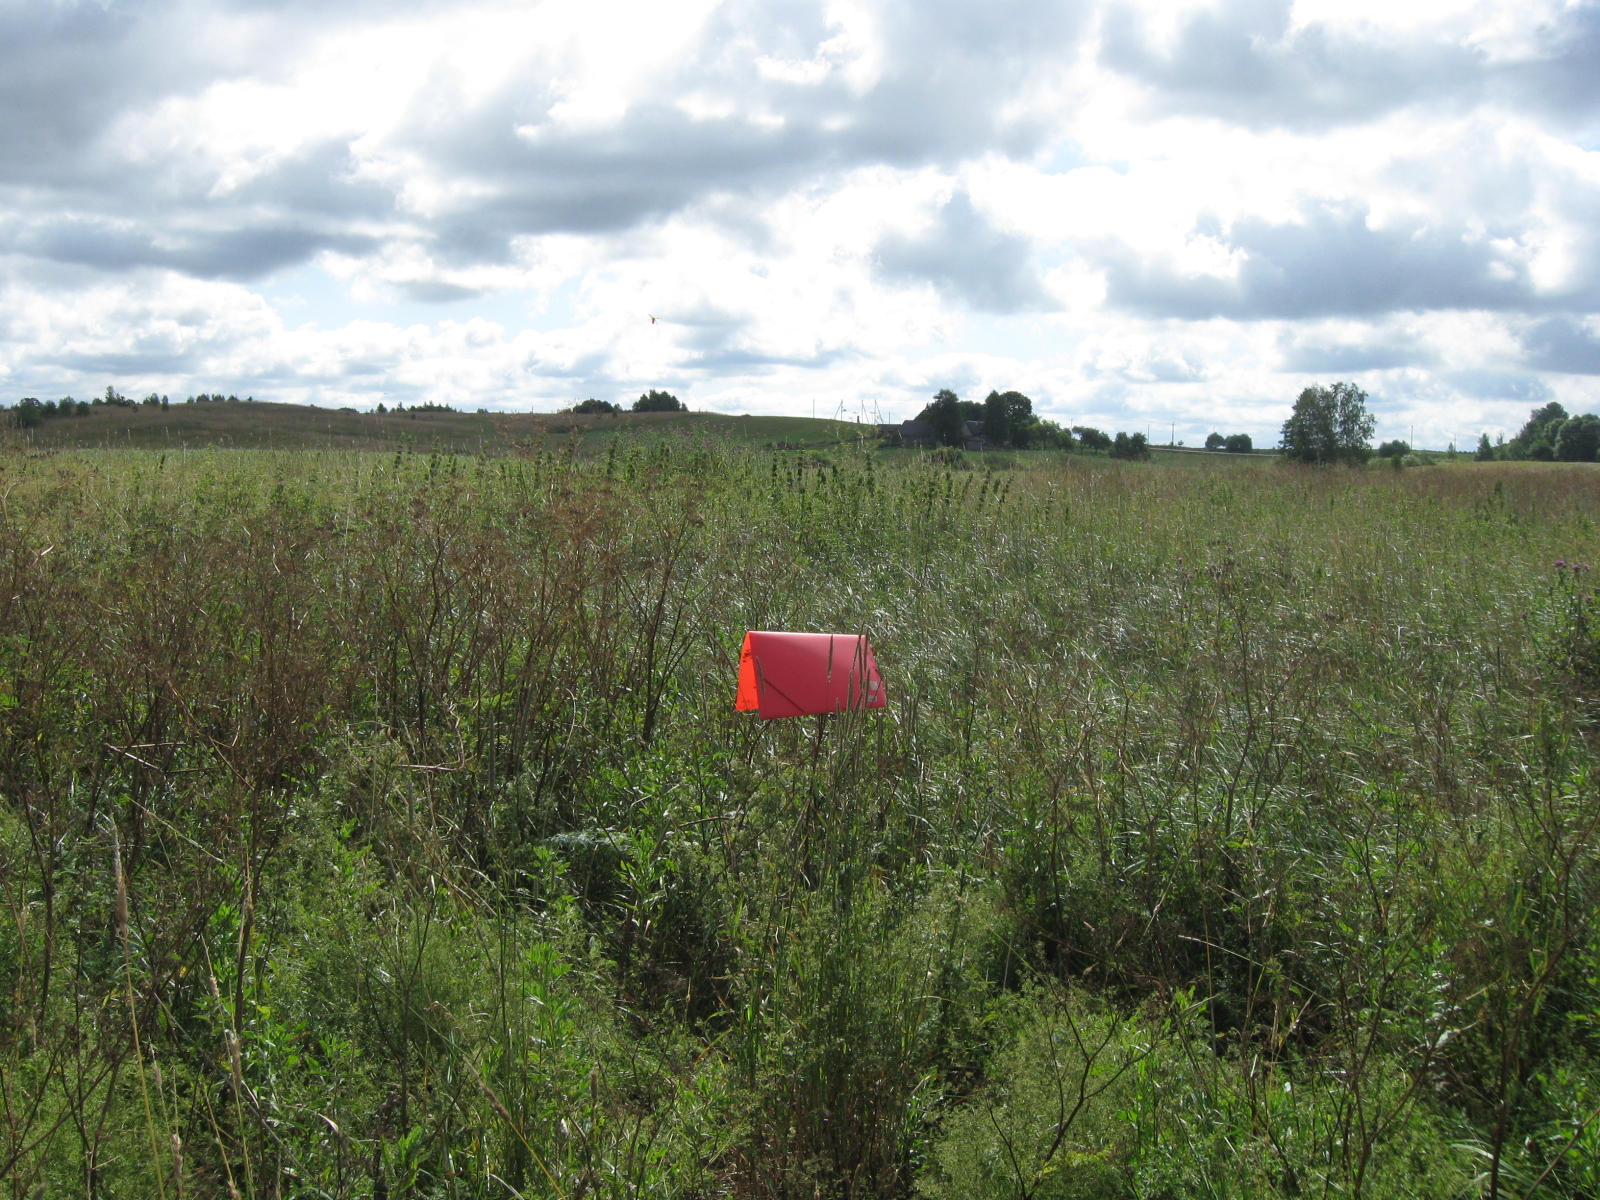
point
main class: Grassland
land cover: Spontaneously vegetated surfaces
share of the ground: > 75 %
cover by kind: herbaceous plants 100 %
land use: Semi-natural and natural areas not in use
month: July
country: LT
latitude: 54.4656
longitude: 24.3084
